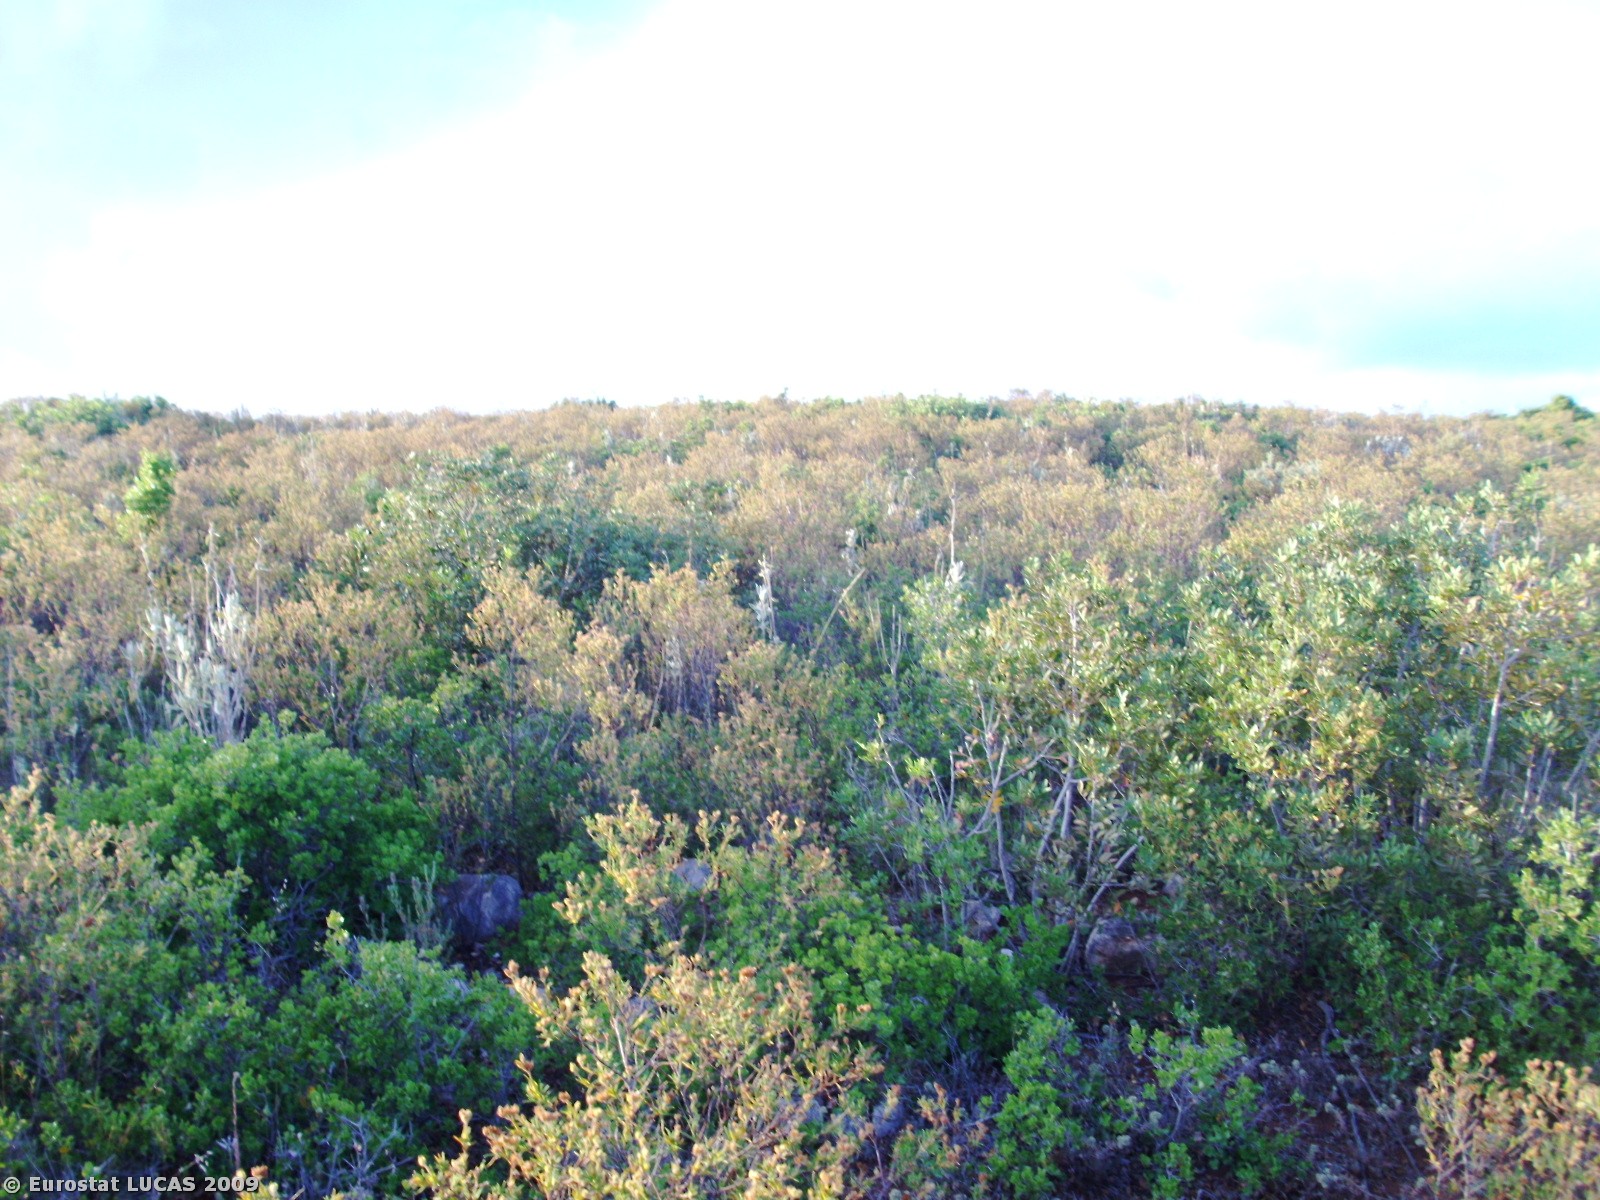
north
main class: Shrubland
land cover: Shrubland without tree cover
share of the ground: > 75 %
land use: Unused
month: June
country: PT
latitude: 37.1523
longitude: -8.7096
